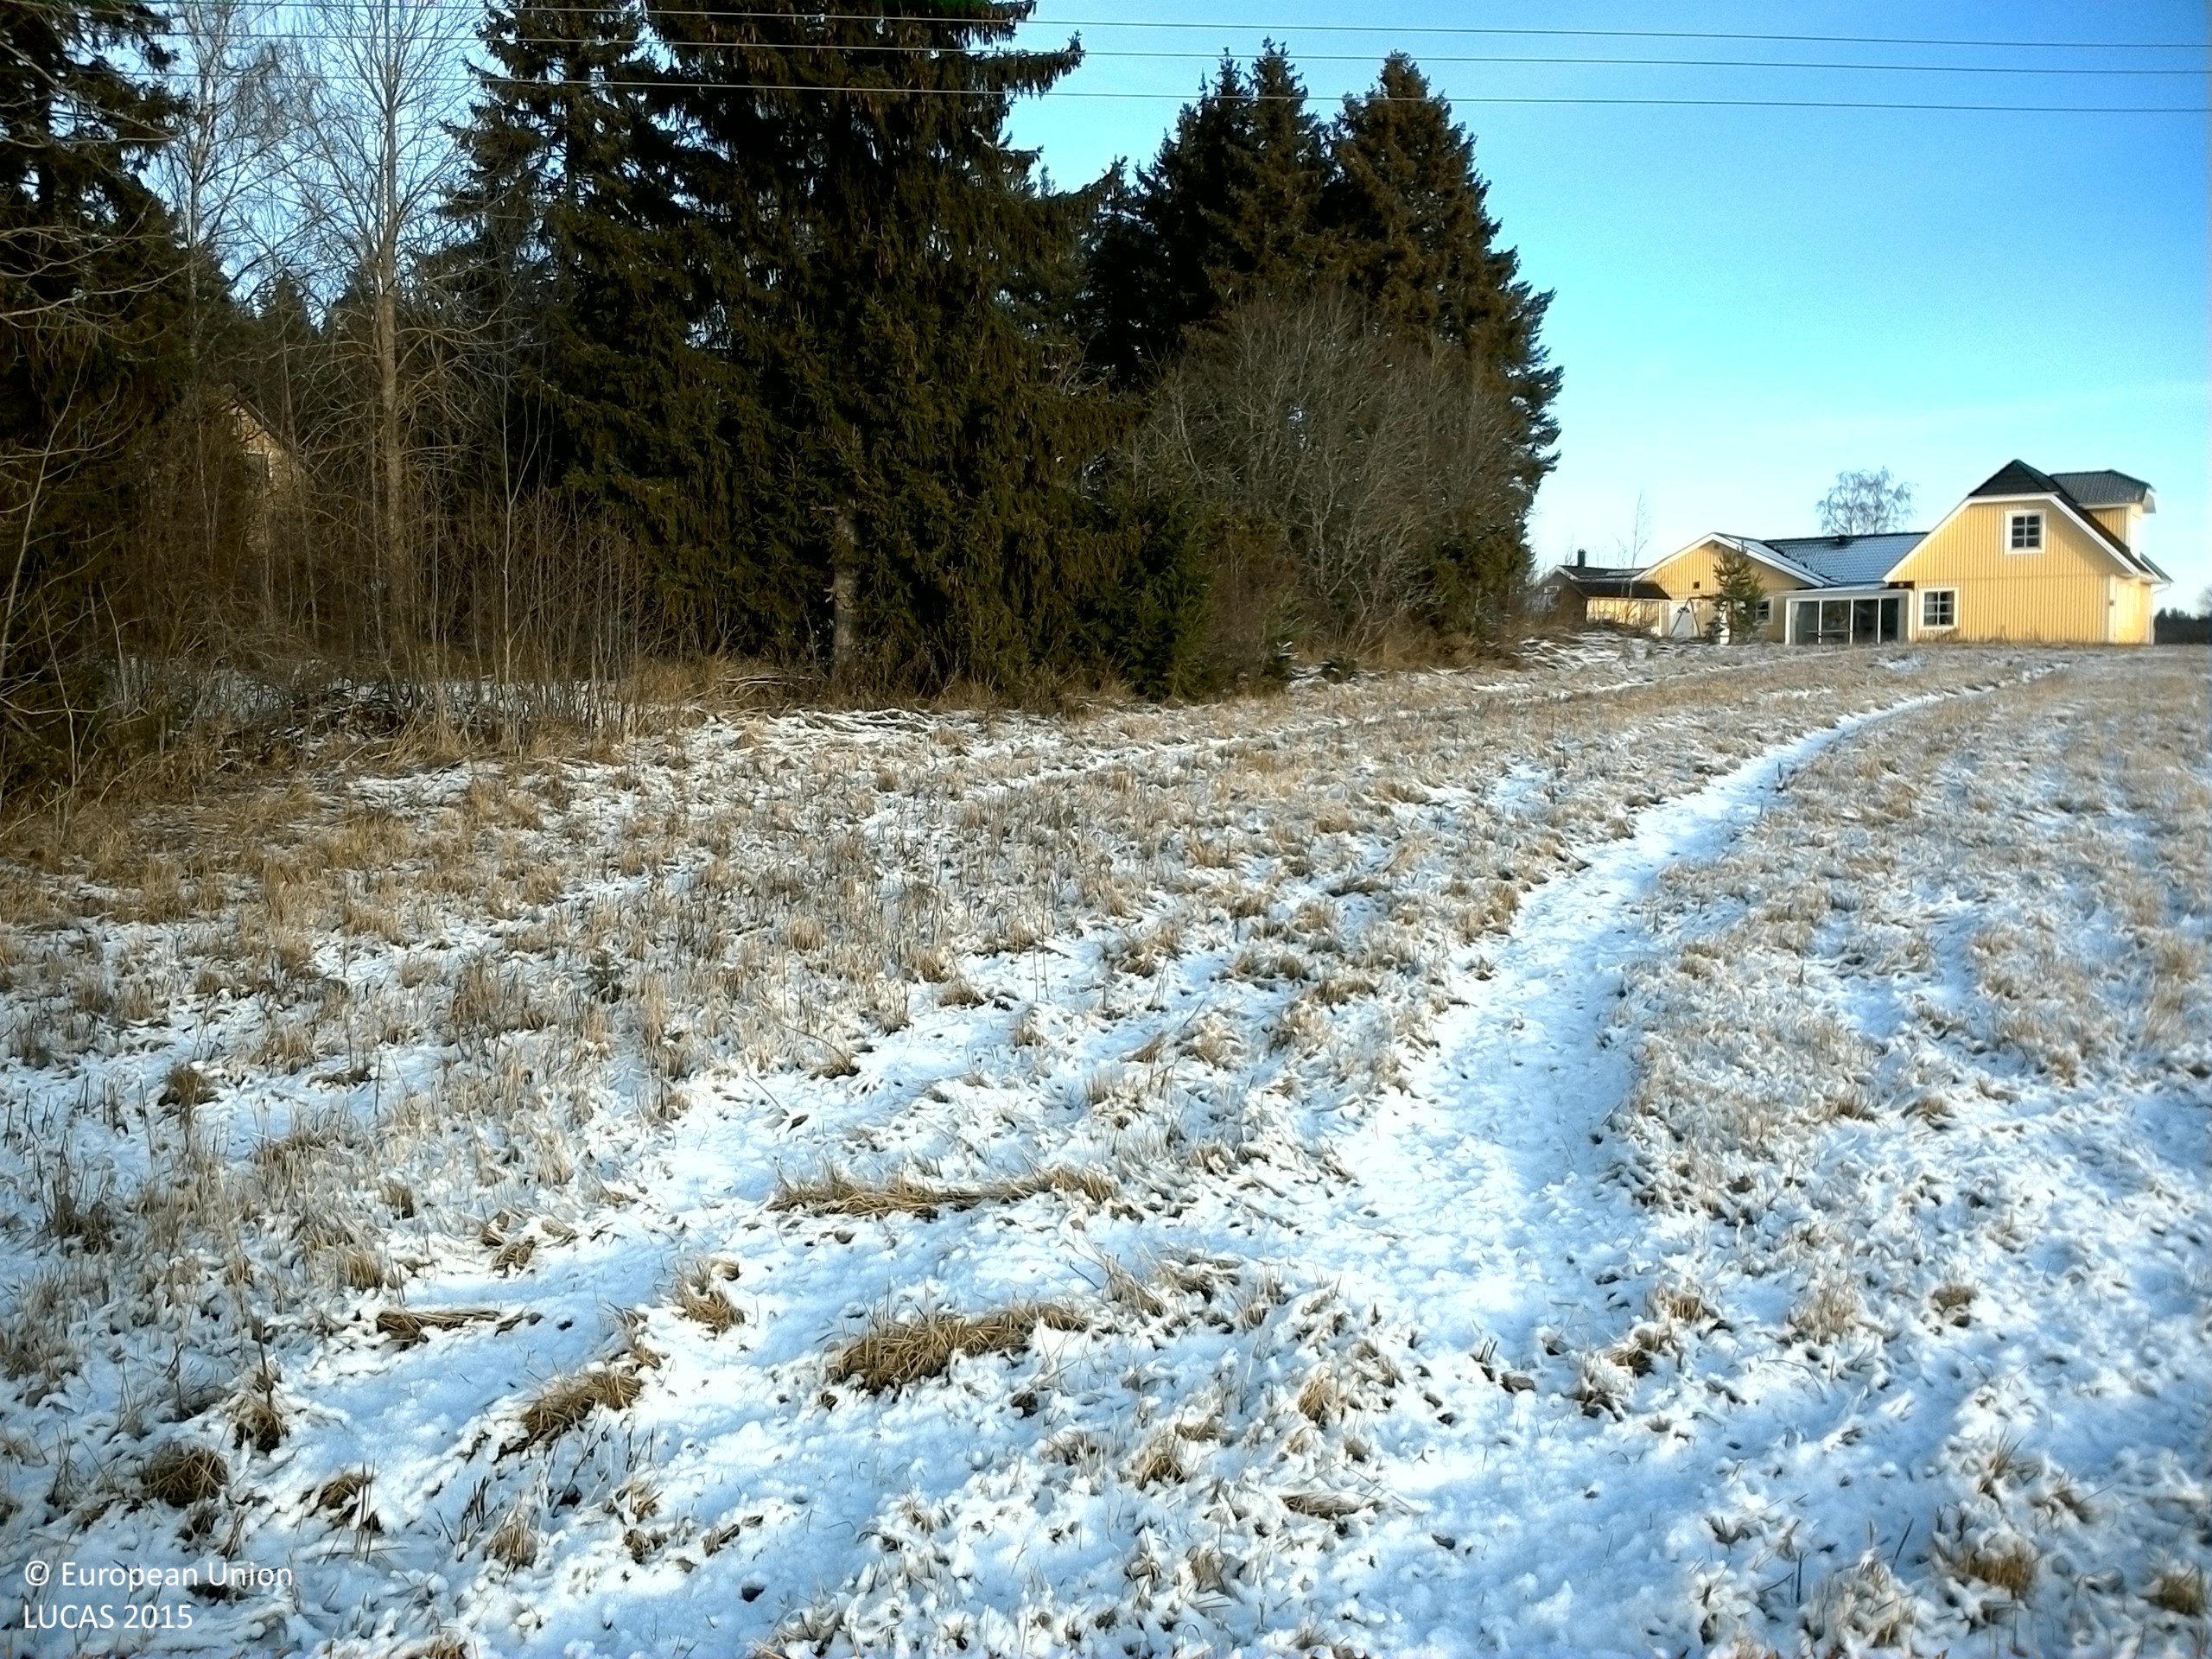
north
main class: Grassland
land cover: Grassland without tree/shrub cover
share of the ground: > 75 %
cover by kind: herbaceous plants 100 %
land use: Agriculture (excluding fallow land and kitchen gardens)
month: December
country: SE
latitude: 59.5666
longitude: 16.3814
